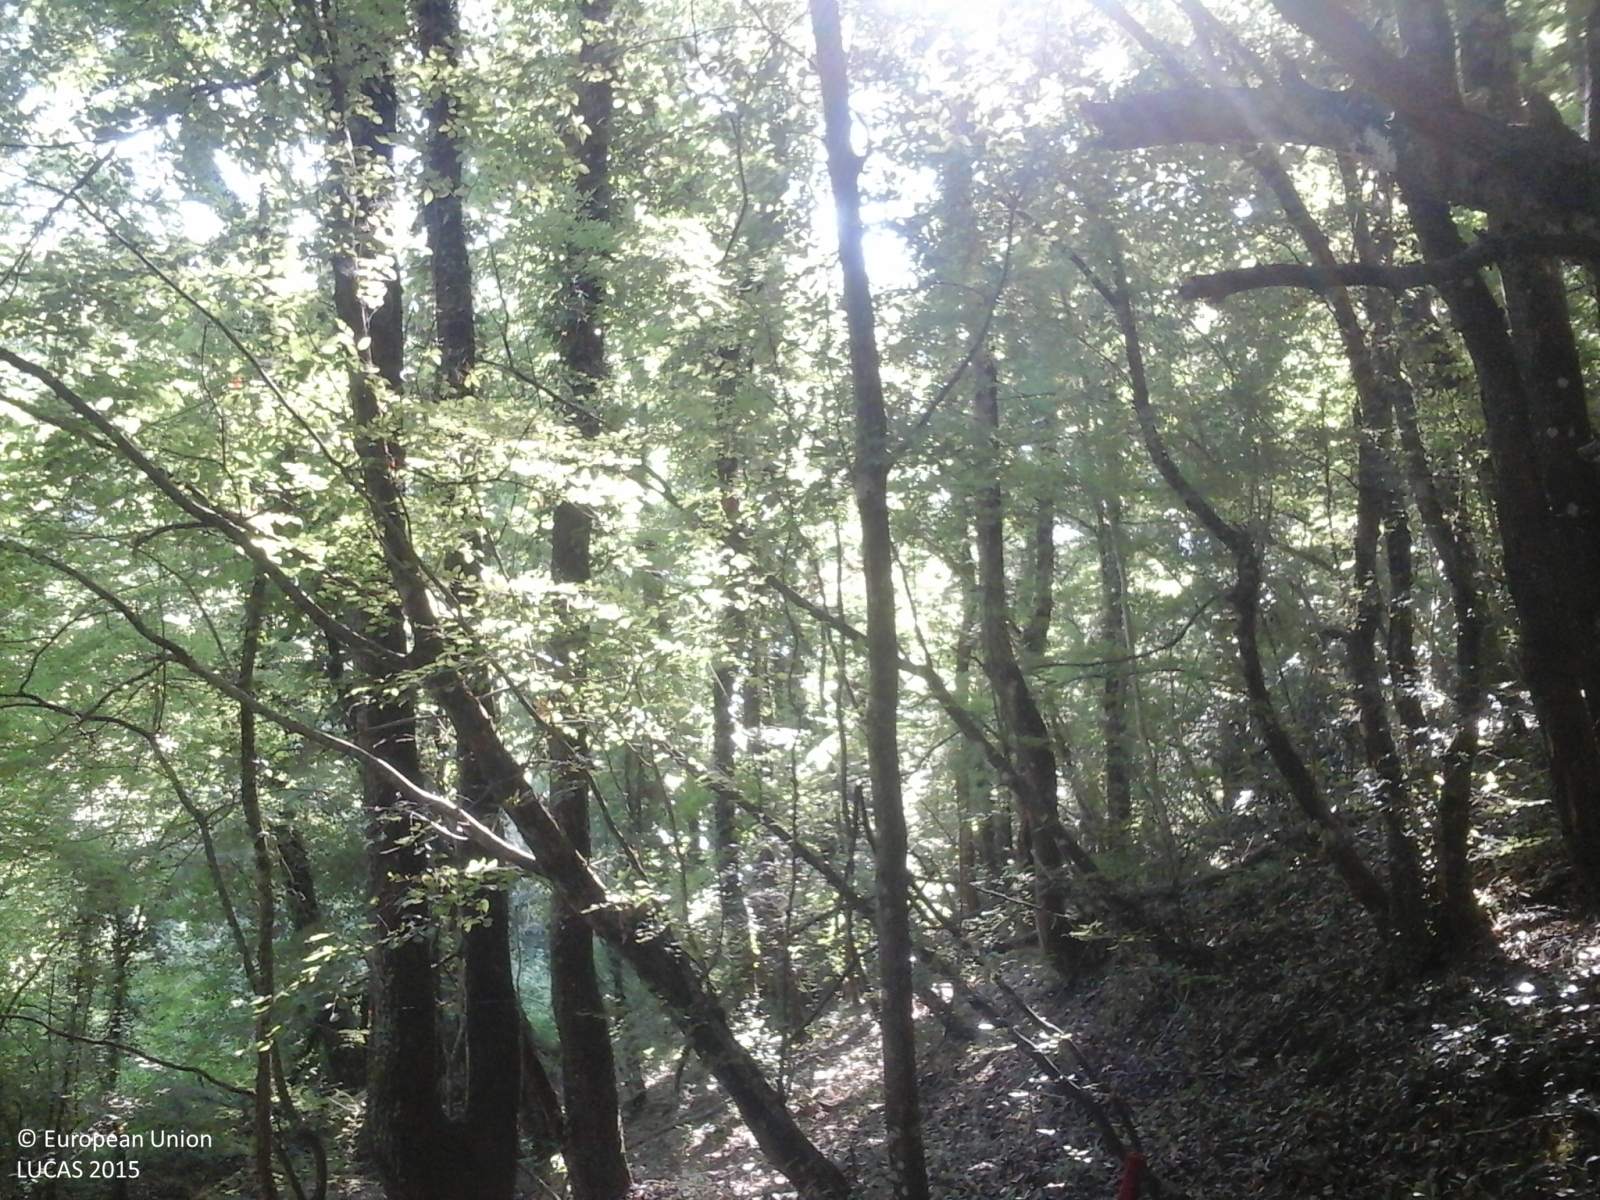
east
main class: Woodland
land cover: Broadleaved woodland
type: thermophilous deciduous forest
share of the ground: > 75 %
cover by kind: broadleaved forest trees 100 %
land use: Forestry
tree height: > 5 m
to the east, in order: Broadleaved woodland; Ditches and canals; Grassland with sparse tree/shrub cover; Fences; Grassland with sparse tree/shrub cover; Electric lines; Fences; Other fresh vegetables; Fences; Other bare soil
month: June
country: IT
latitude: 42.2160
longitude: 12.8612
